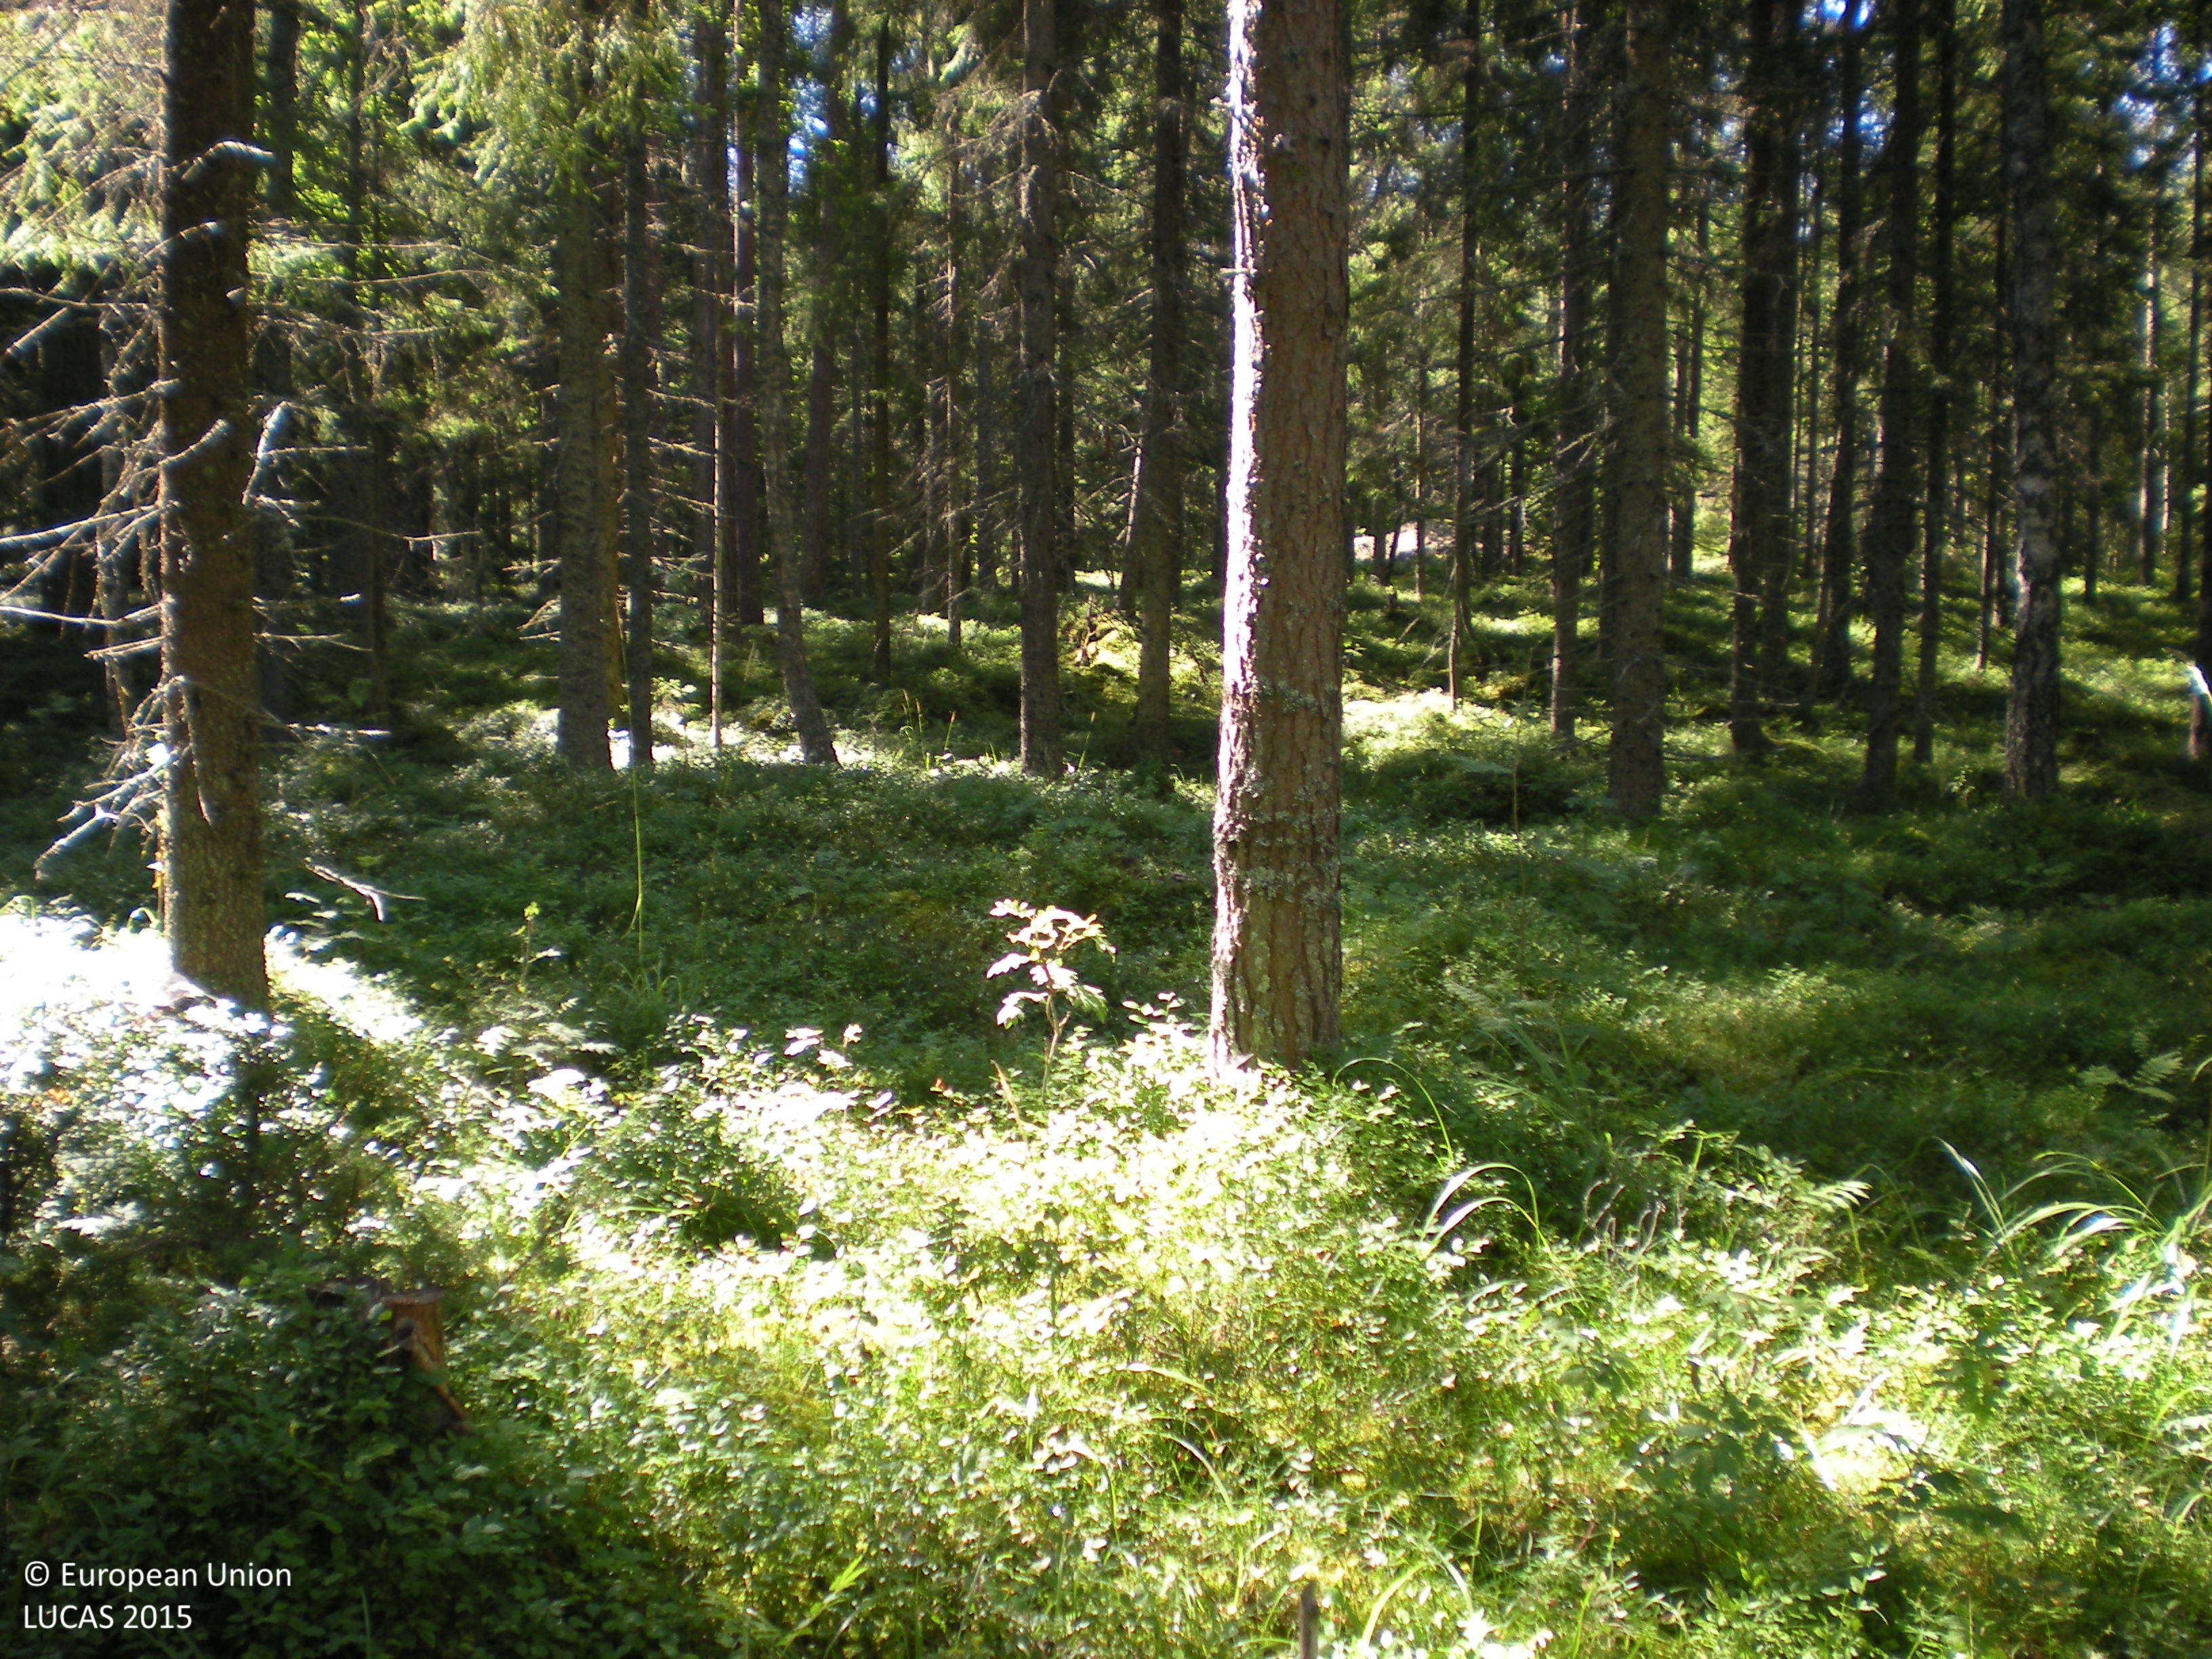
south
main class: Woodland
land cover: Pine dominated coniferous woodland
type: boreal forest
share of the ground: 50 - 75 %
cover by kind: coniferous forest trees 60 %, shrubs 20 %, broadleaved forest trees 10 %, herbaceous plants 5 %, lichens and mosses 5 %
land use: Forestry
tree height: > 5 m
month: August
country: SE
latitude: 60.7601
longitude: 17.1278
